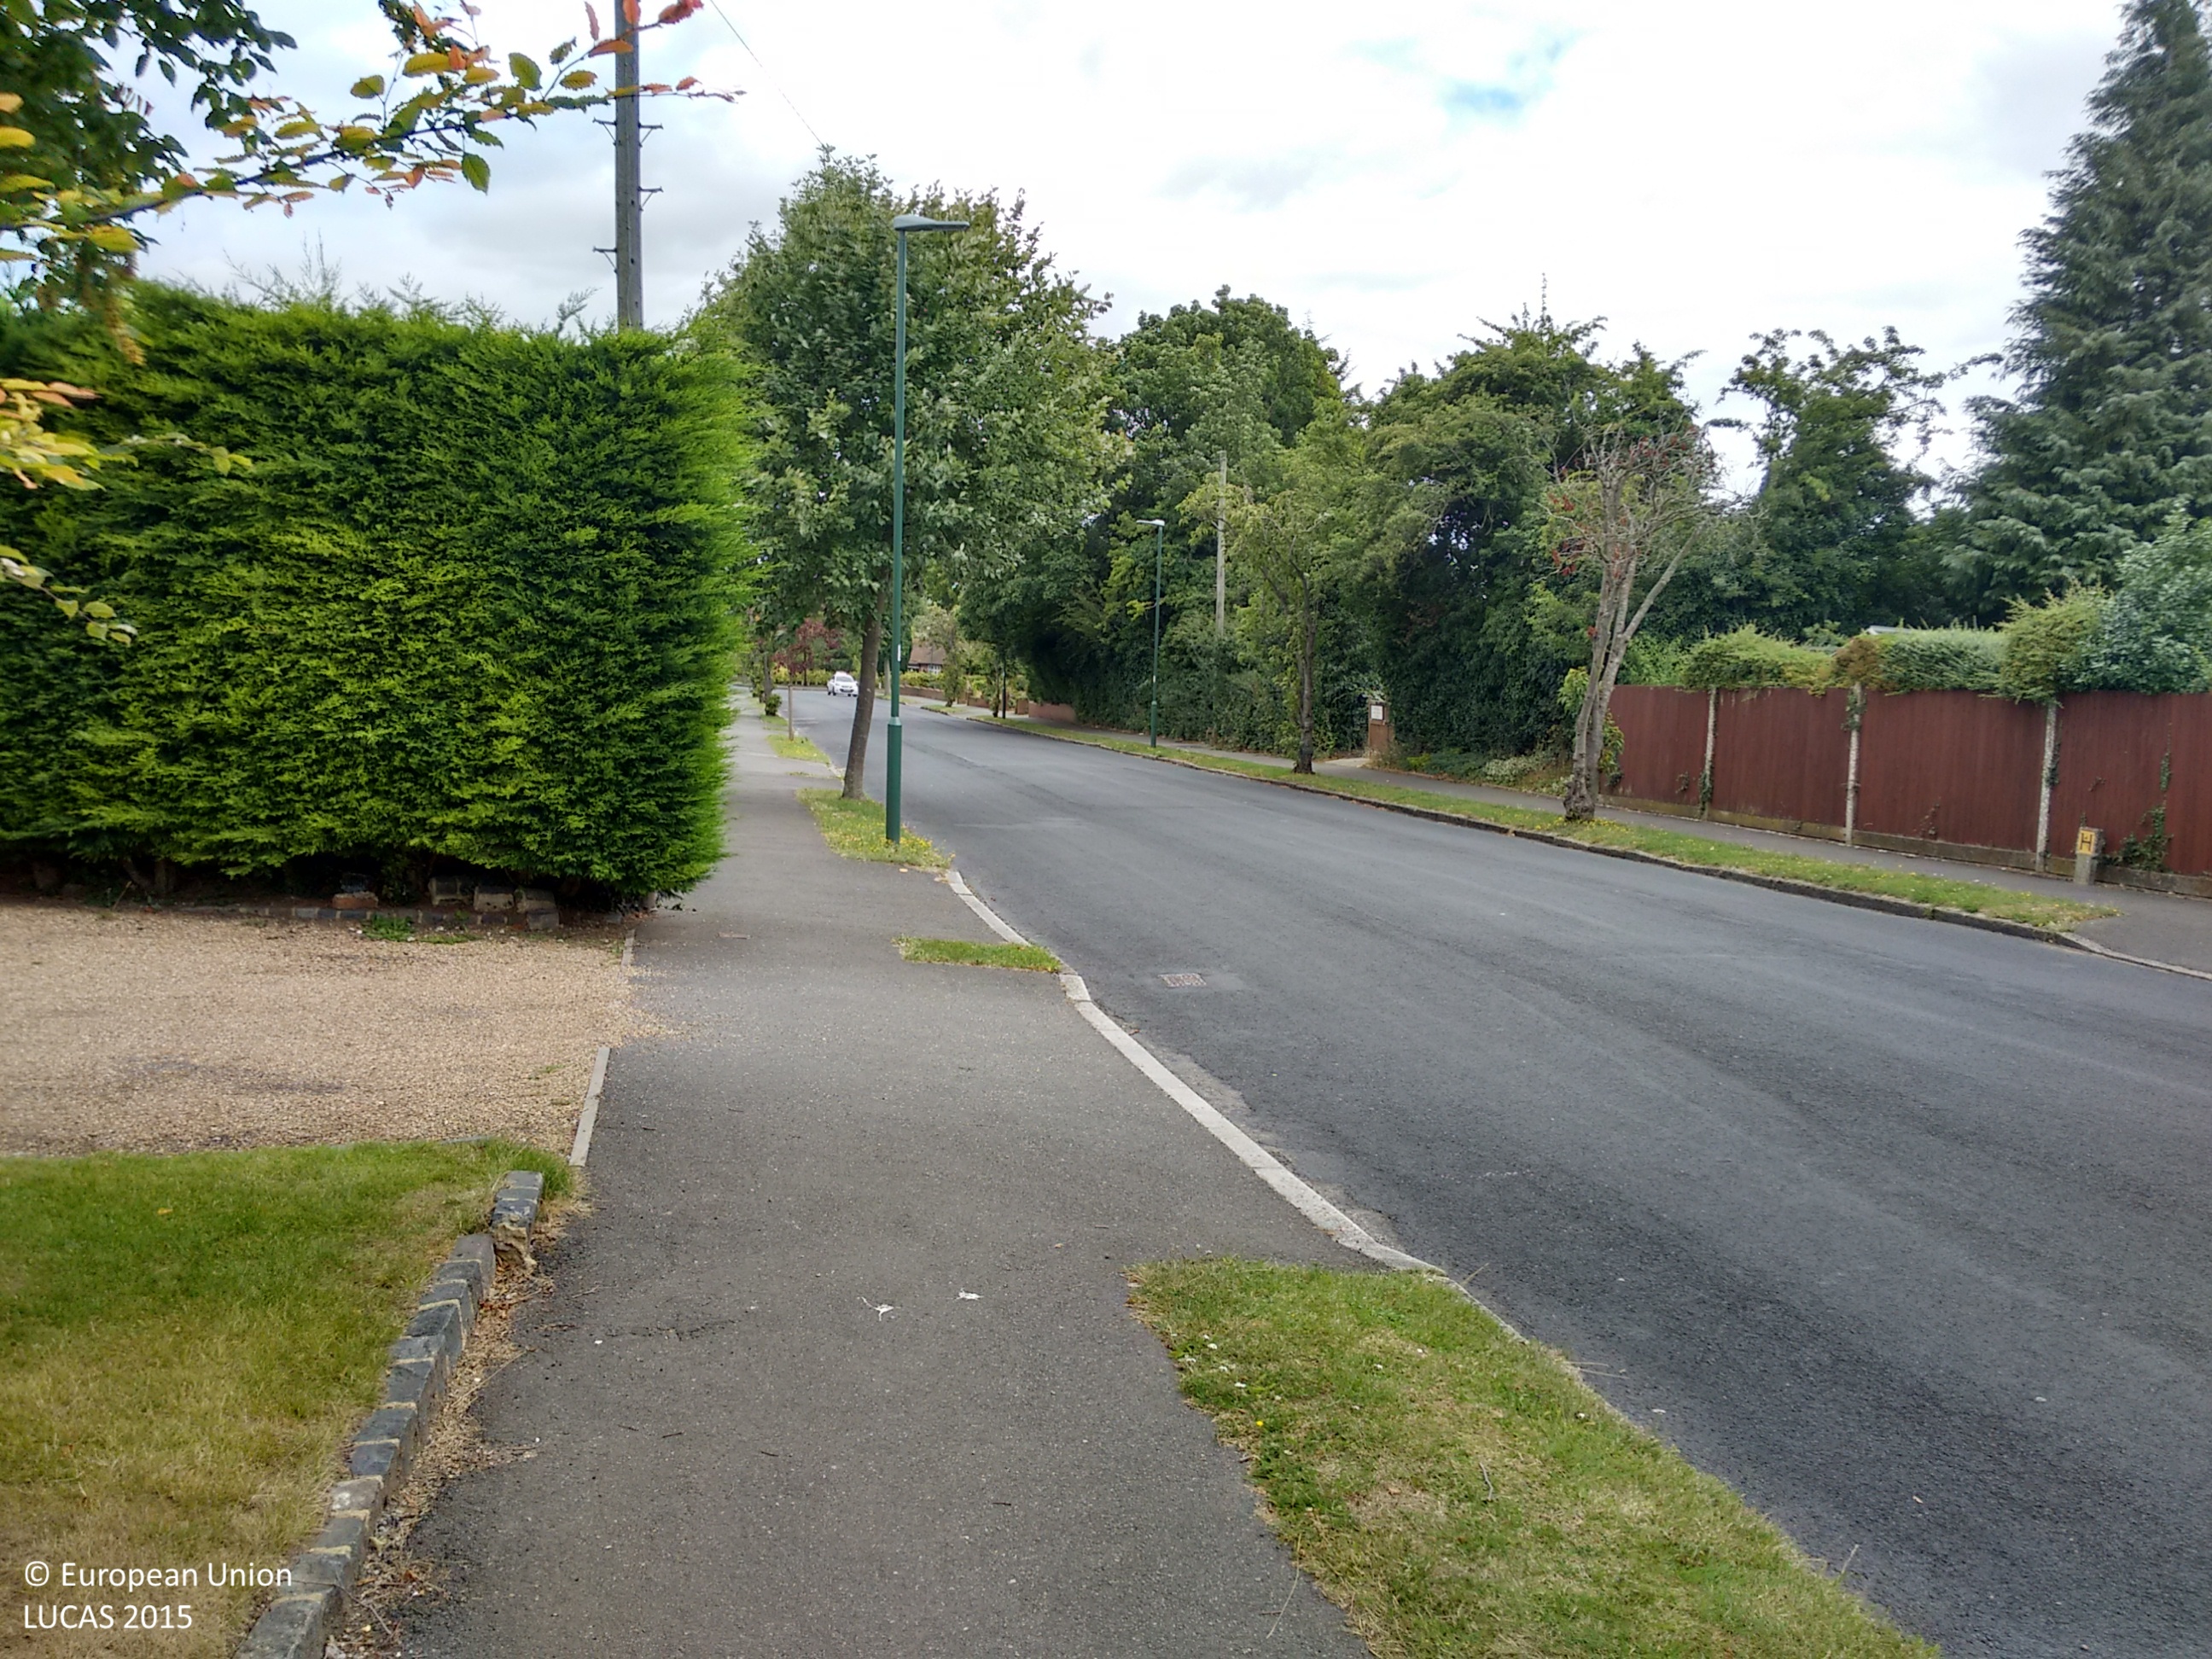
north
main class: Grassland
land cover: Grassland with sparse tree/shrub cover
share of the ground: > 75 %
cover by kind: herbaceous plants 95 %, coniferous forest trees 5 %
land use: Residential
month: August
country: GB
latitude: 51.3377
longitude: -0.2124
